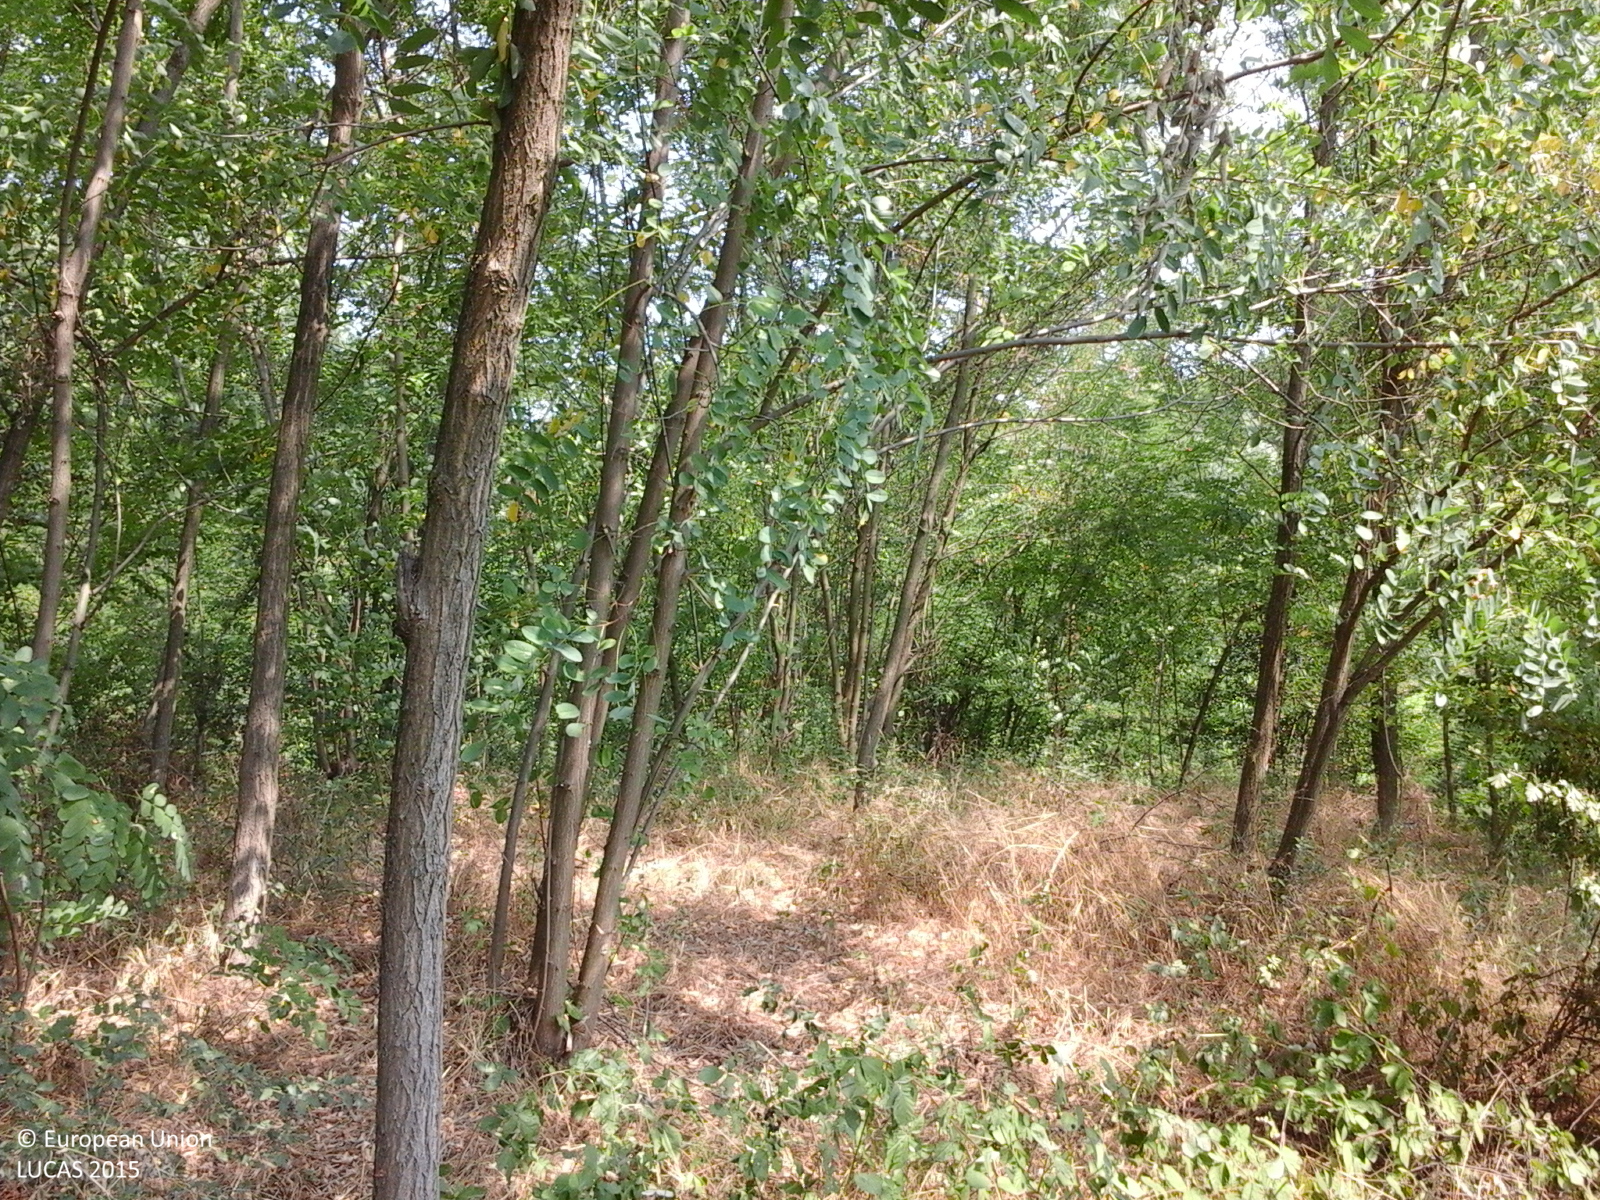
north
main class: Woodland
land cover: Broadleaved woodland
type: exotic forest
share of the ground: > 75 %
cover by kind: broadleaved forest trees 100 %
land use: Forestry
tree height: > 5 m
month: August
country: RO
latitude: 44.5211
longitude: 23.3753
